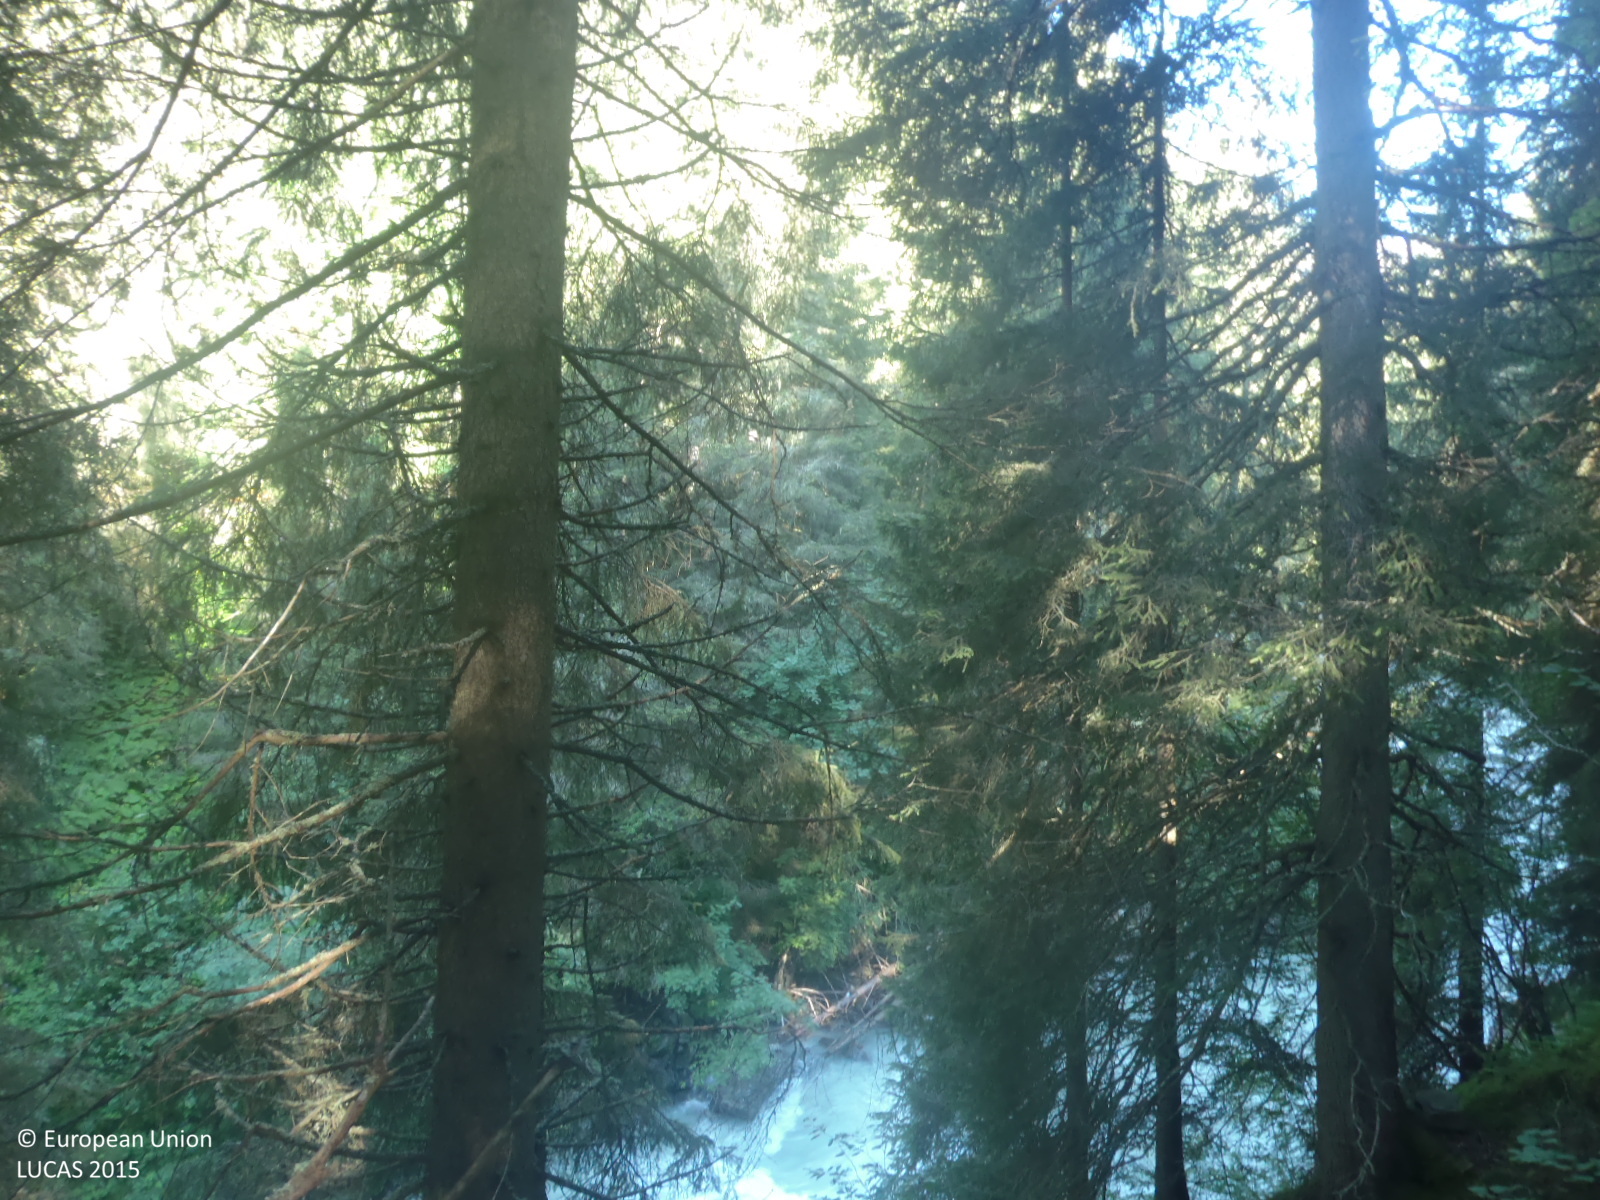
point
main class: Woodland
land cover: Spruce dominated coniferous woodland
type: alpine coniferous forest
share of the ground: > 75 %
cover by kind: coniferous forest trees 95 %, broadleaved forest trees 5 %
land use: Forestry
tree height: > 5 m
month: August
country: AT
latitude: 47.0964
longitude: 12.5143
